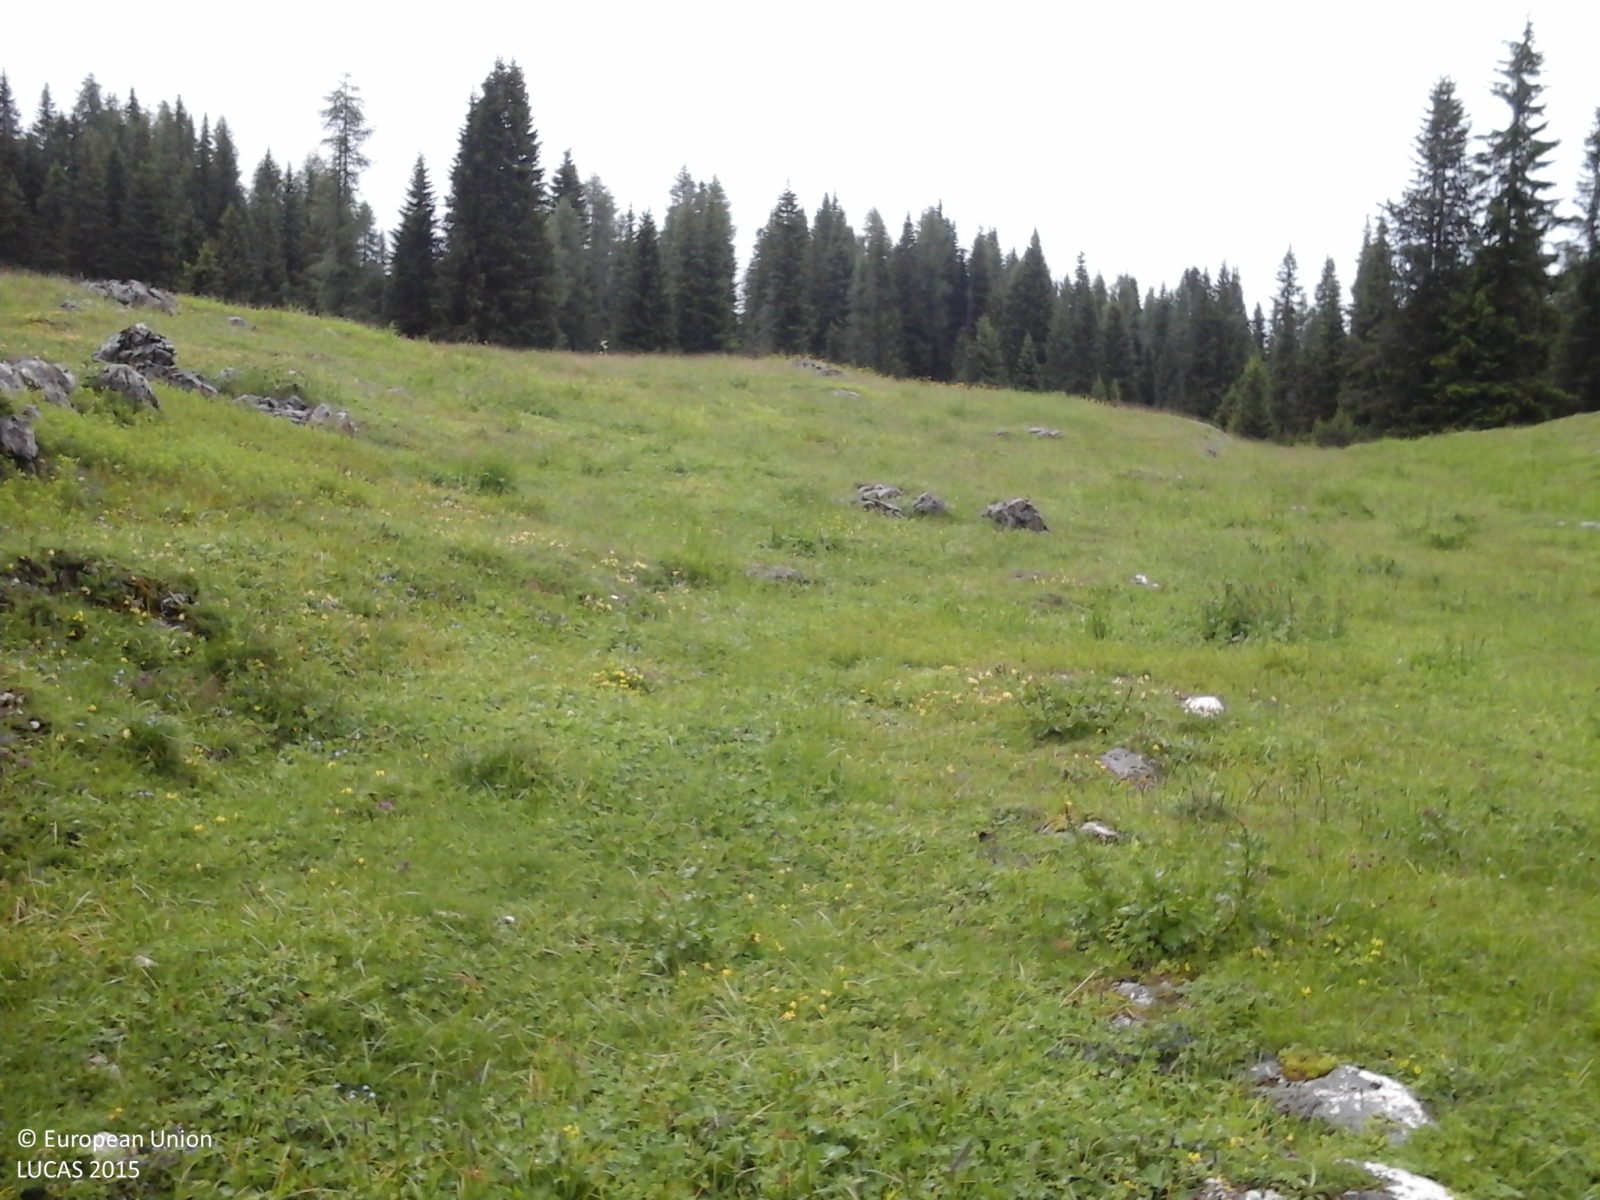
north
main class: Grassland
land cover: Grassland without tree/shrub cover
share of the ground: > 75 %
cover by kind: herbaceous plants 100 %
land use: Agriculture (excluding fallow land and kitchen gardens)
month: June
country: IT
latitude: 45.9799
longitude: 11.5338
